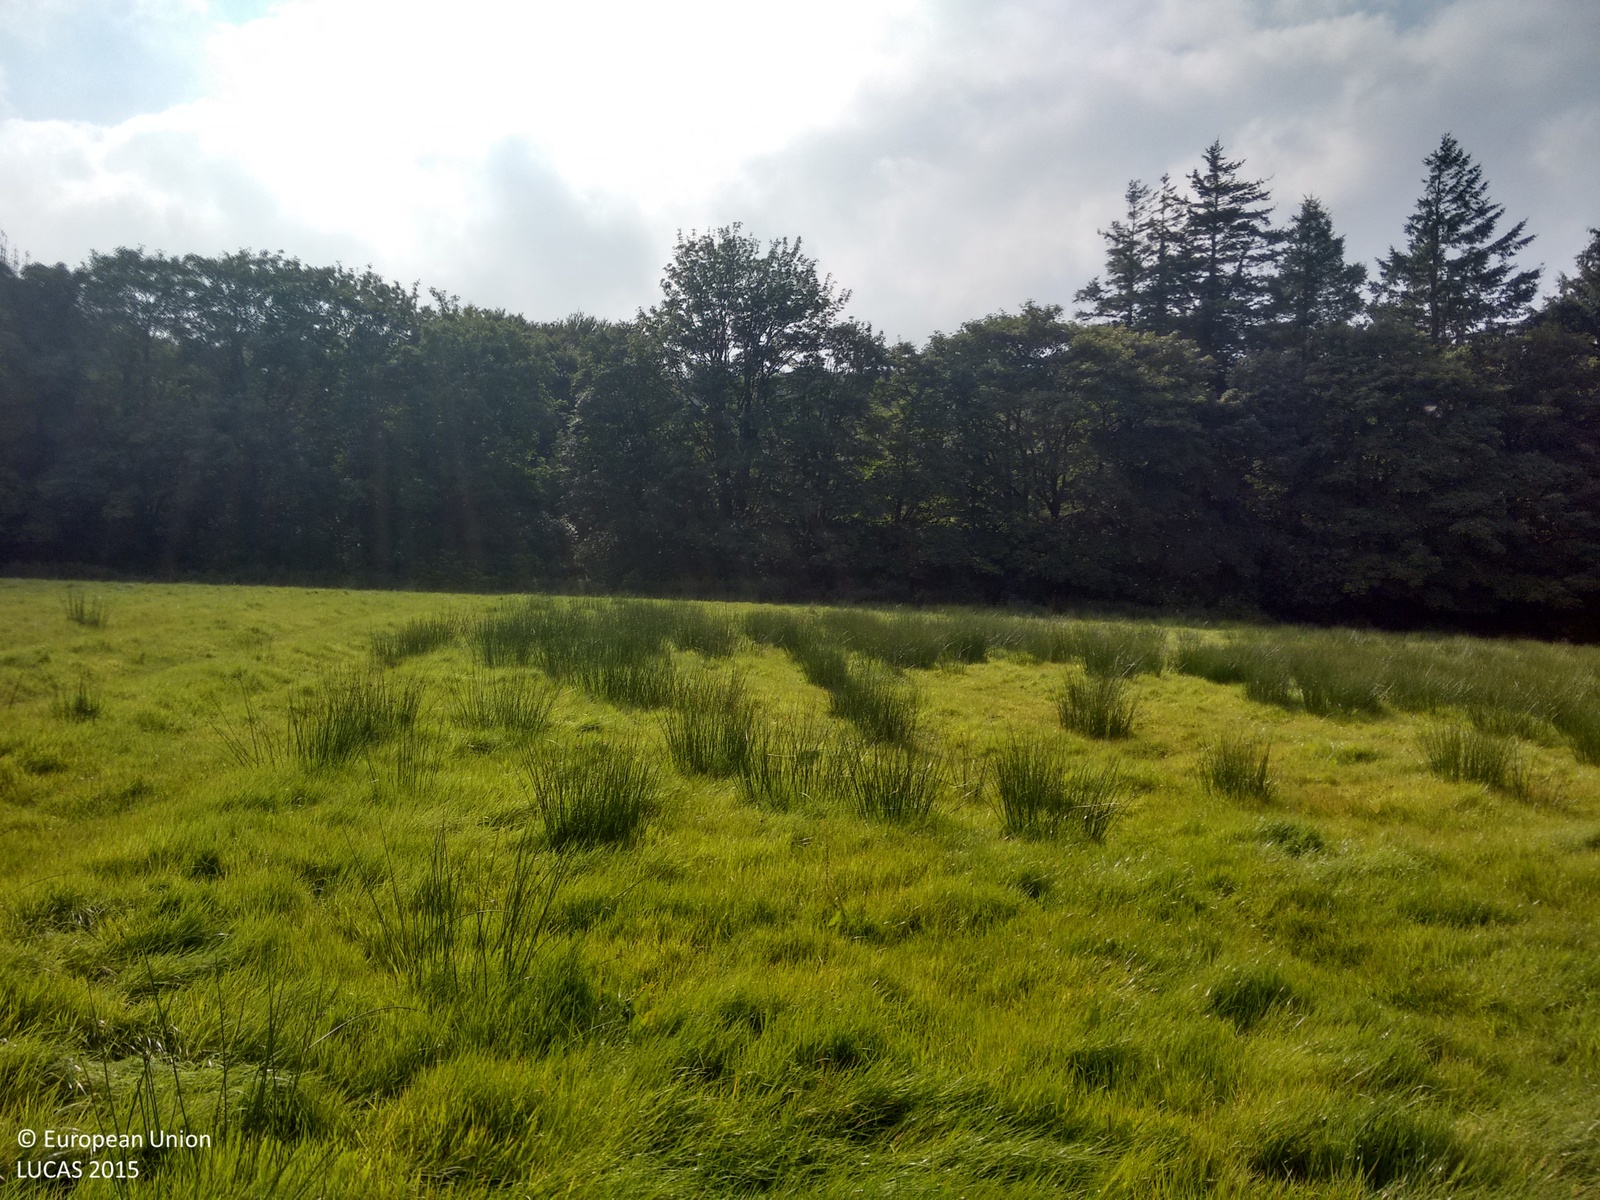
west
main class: Grassland
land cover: Grassland without tree/shrub cover
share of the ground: > 75 %
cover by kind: herbaceous plants 100 %
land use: Agriculture (excluding fallow land and kitchen gardens)
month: September
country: GB
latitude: 55.0814
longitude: -4.9786
